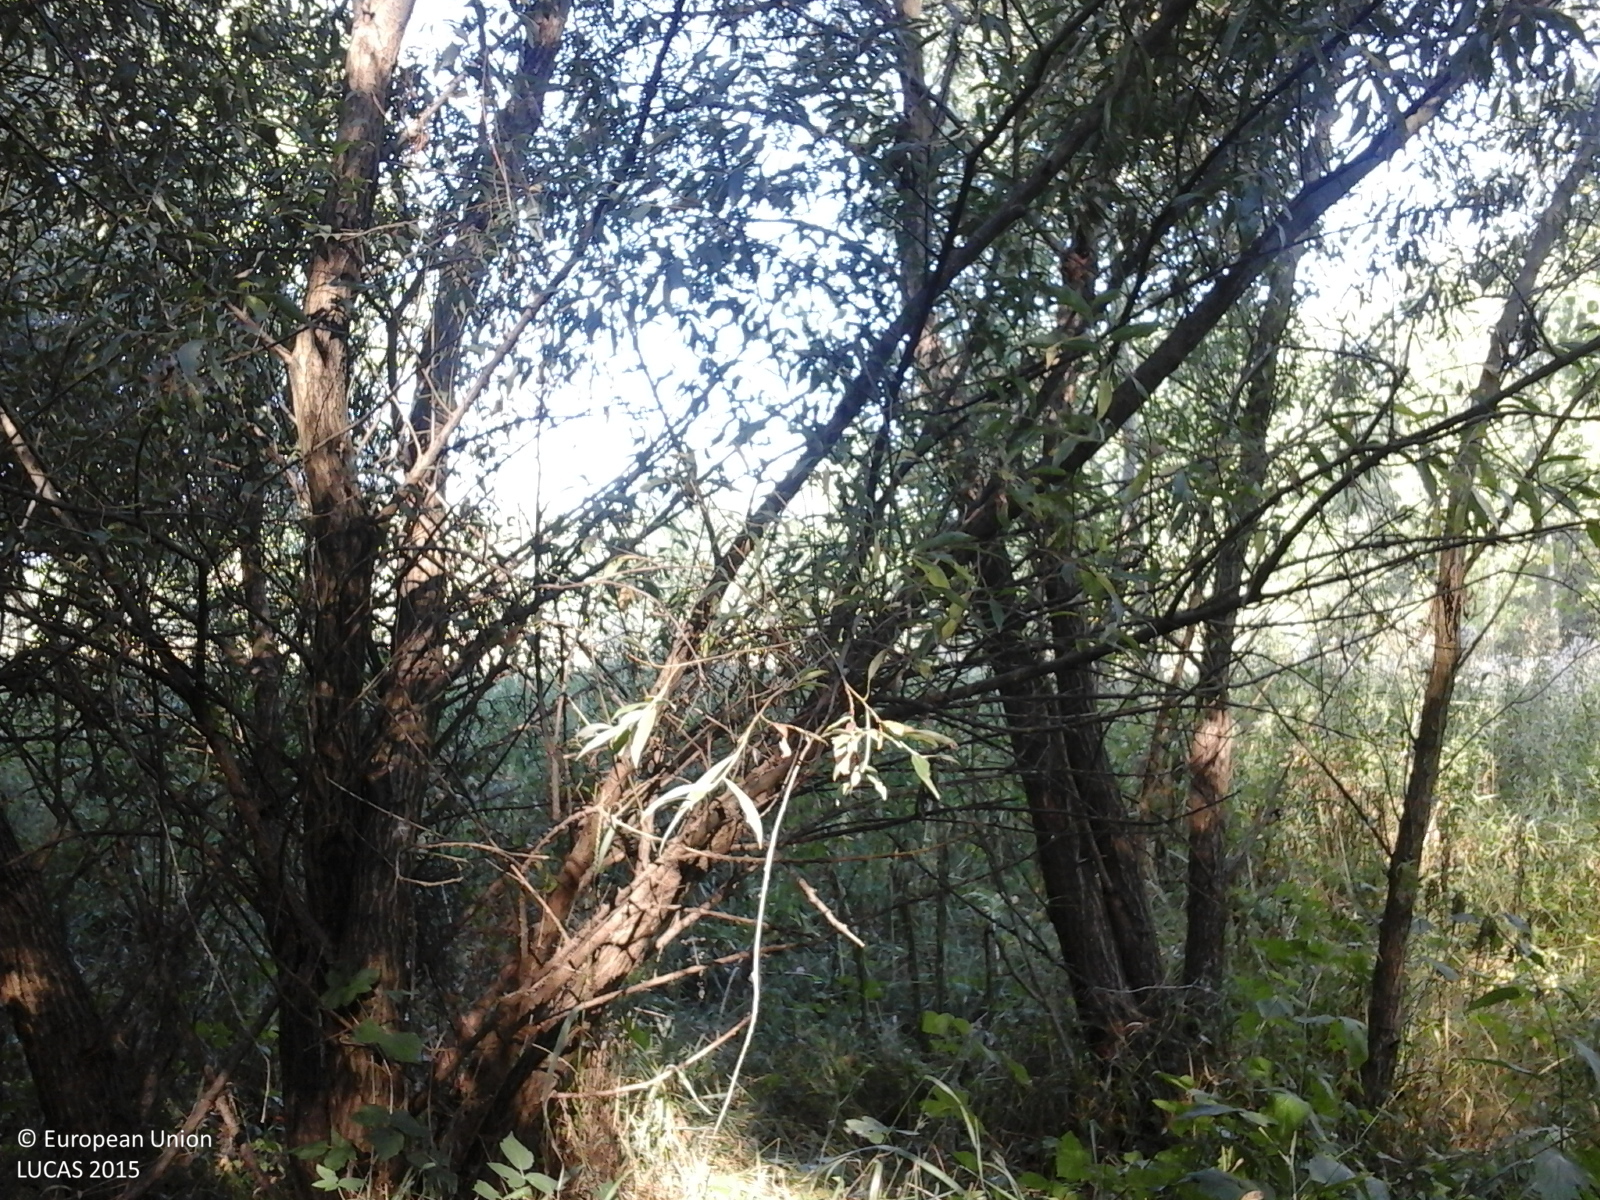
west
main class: Woodland
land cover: Broadleaved woodland
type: floodplain forest
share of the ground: > 75 %
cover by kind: broadleaved forest trees 100 %
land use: Forestry
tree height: > 5 m
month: July
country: RO
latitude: 46.3051
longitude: 28.1917
